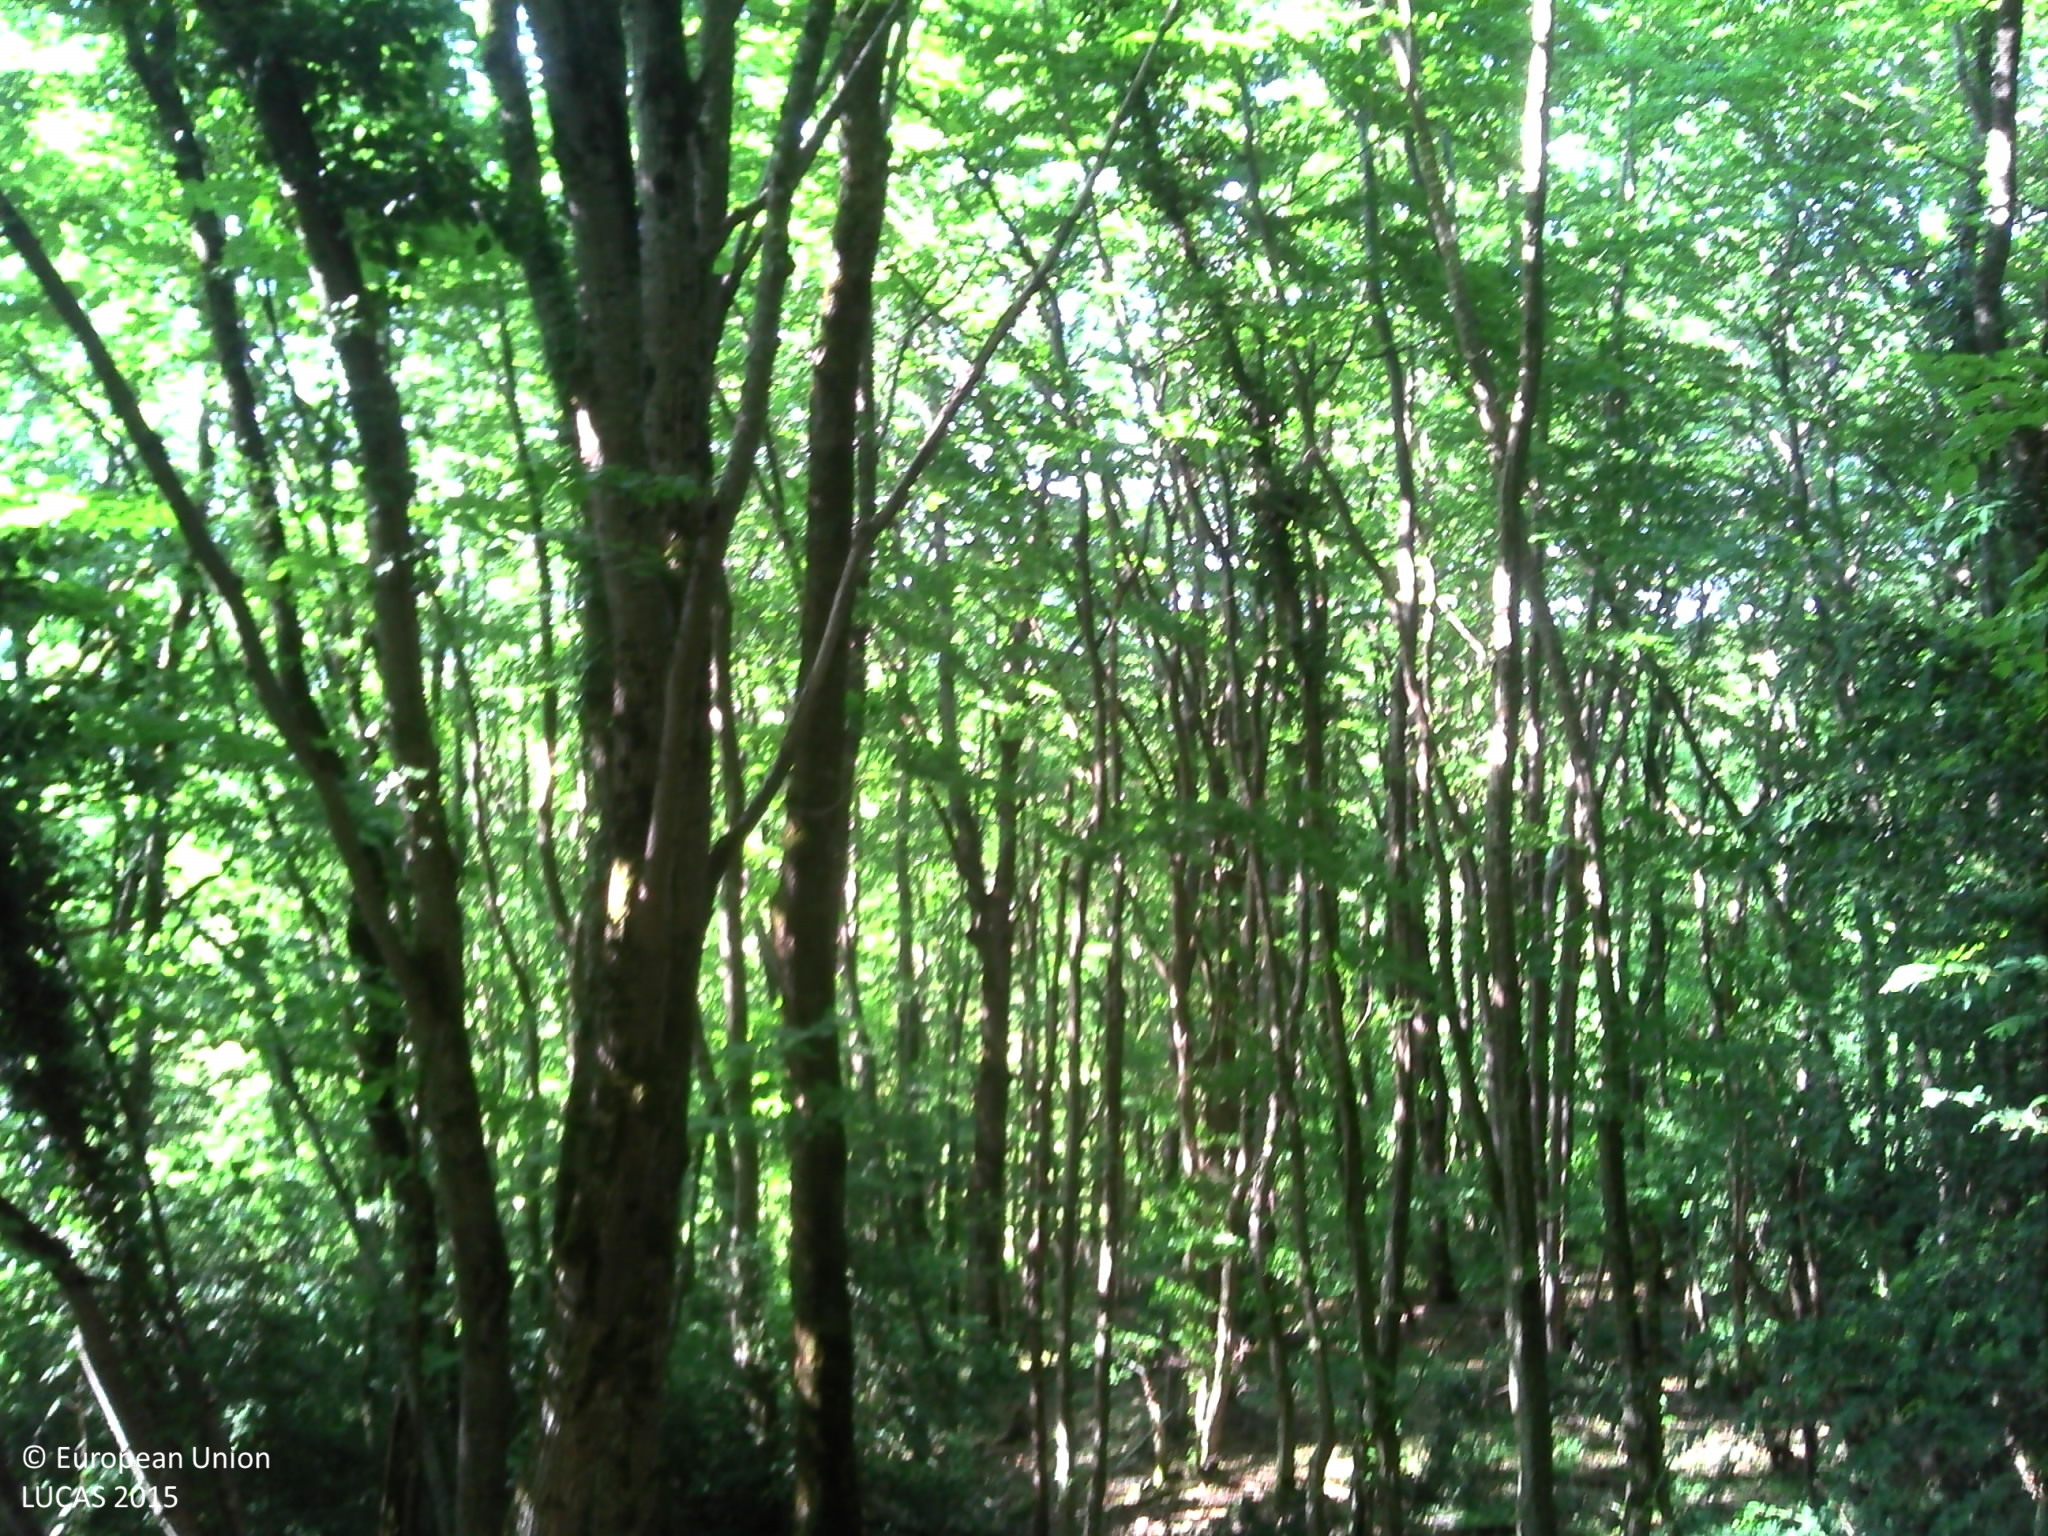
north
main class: Woodland
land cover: Broadleaved woodland
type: acidophilous oak and oak-birch forest
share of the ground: > 75 %
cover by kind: broadleaved forest trees 80 %, herbaceous plants 10 %, lichens and mosses 10 %
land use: Forestry
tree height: > 5 m
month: June
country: FR
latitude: 46.6046
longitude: 4.8187
